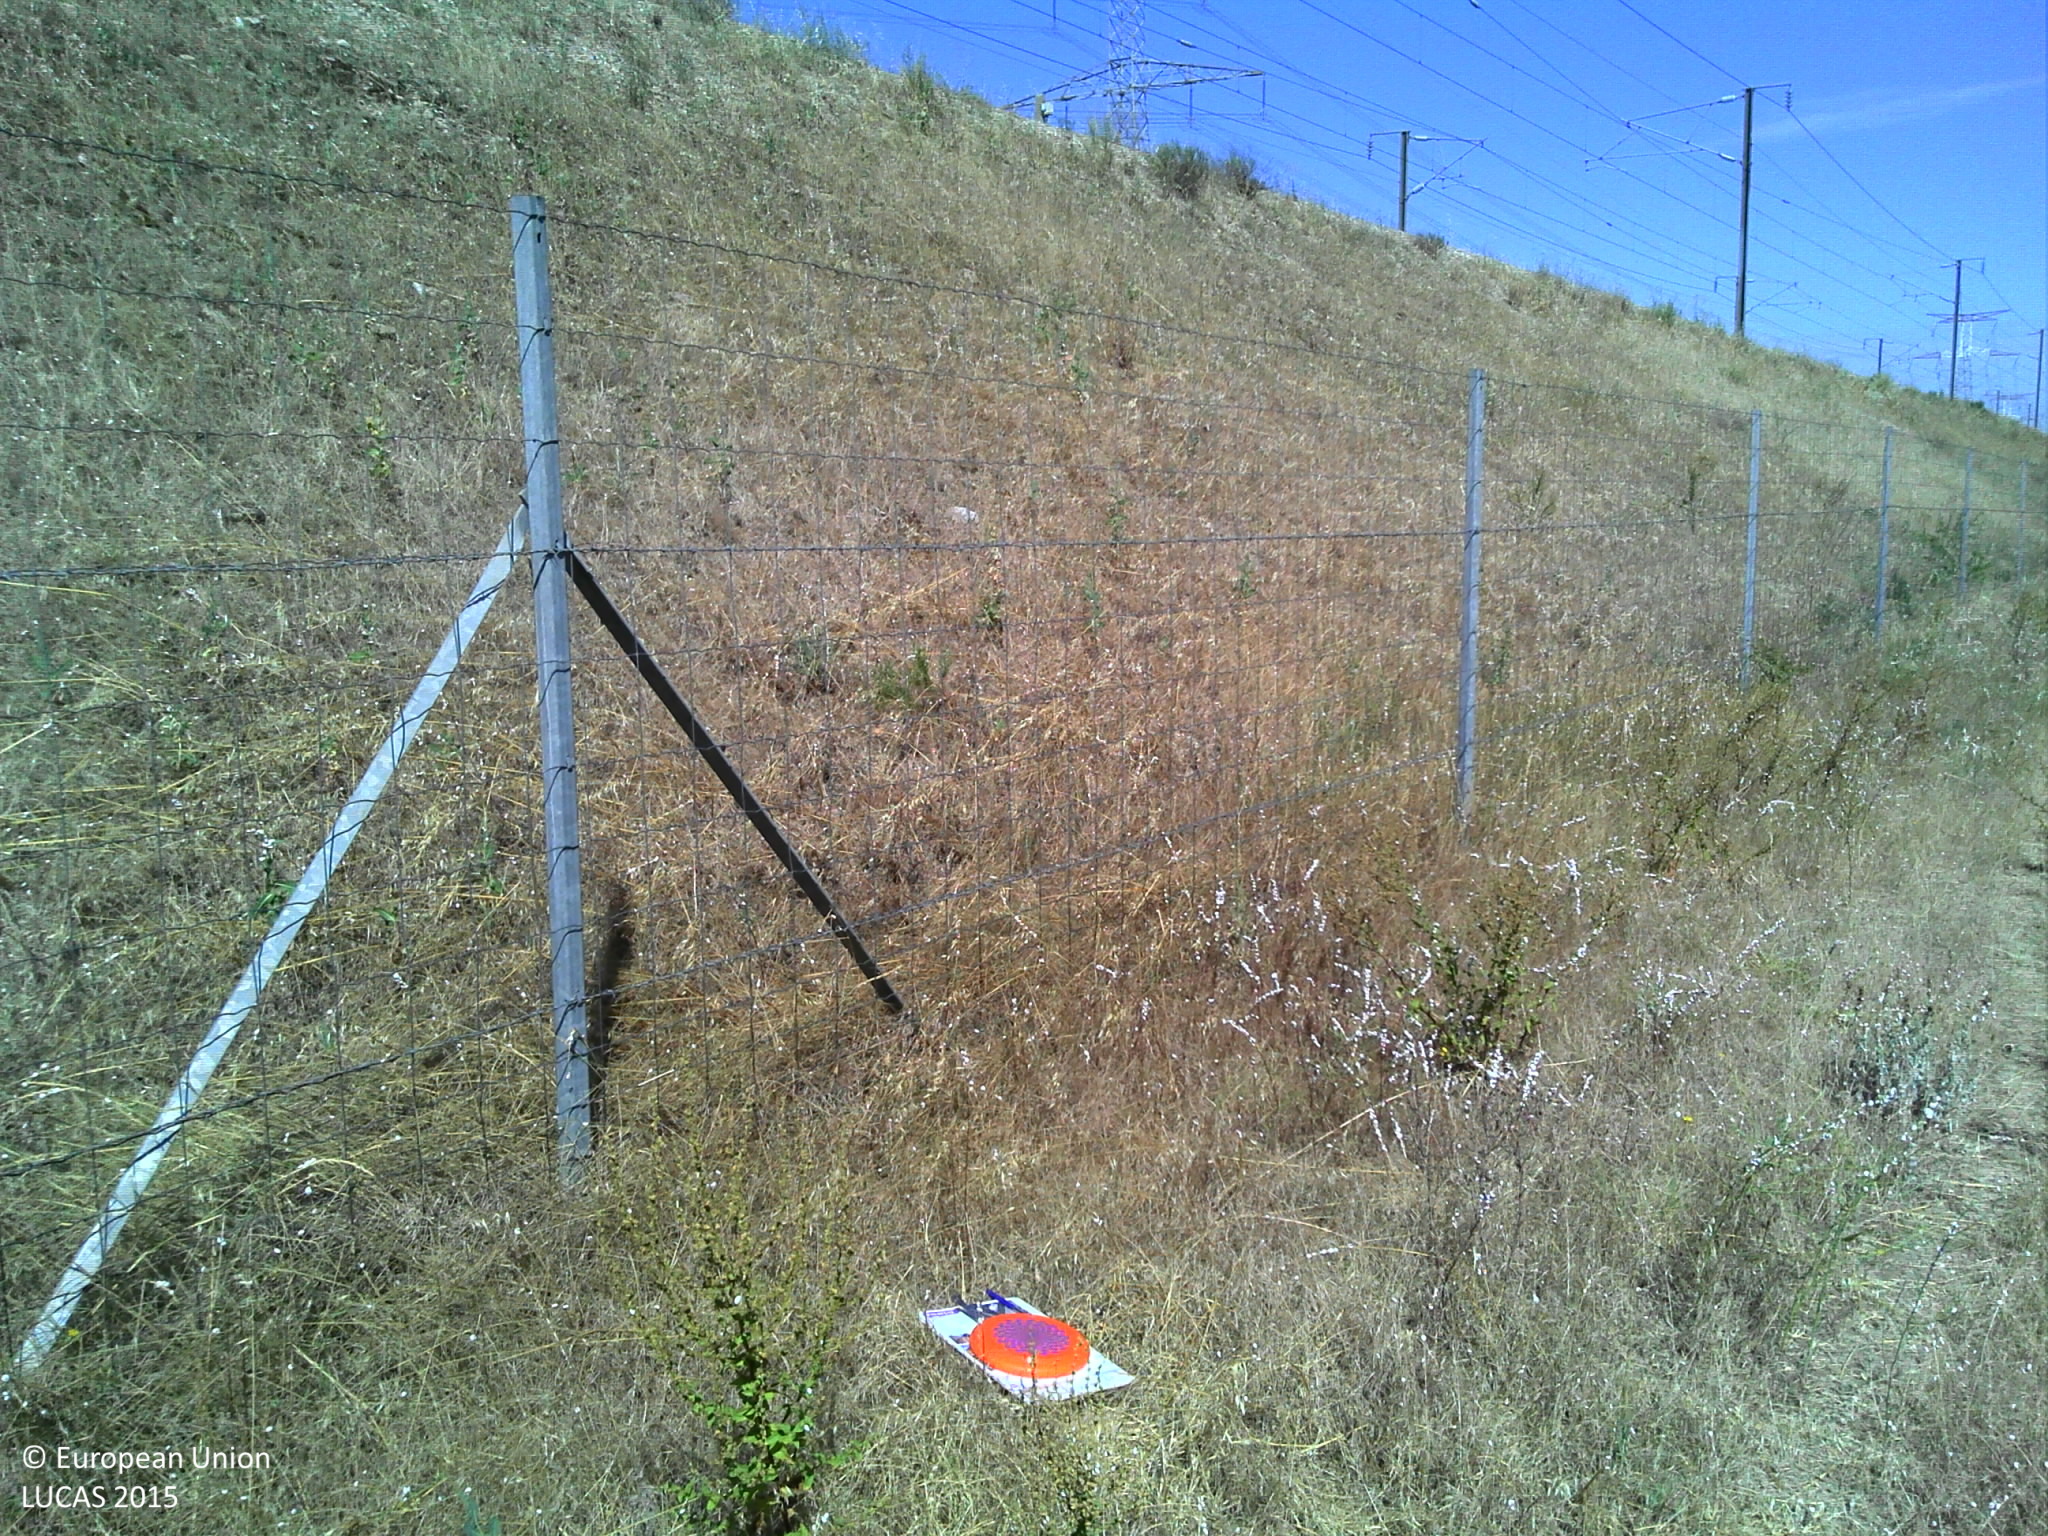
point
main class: Shrubland
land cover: Shrubland without tree cover
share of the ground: > 75 %
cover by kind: herbaceous plants 75 %, shrubs 20 %, unconsolidated bare surface 5 %
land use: Semi-natural and natural areas not in use
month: July
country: FR
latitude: 43.7988
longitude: 5.0499
